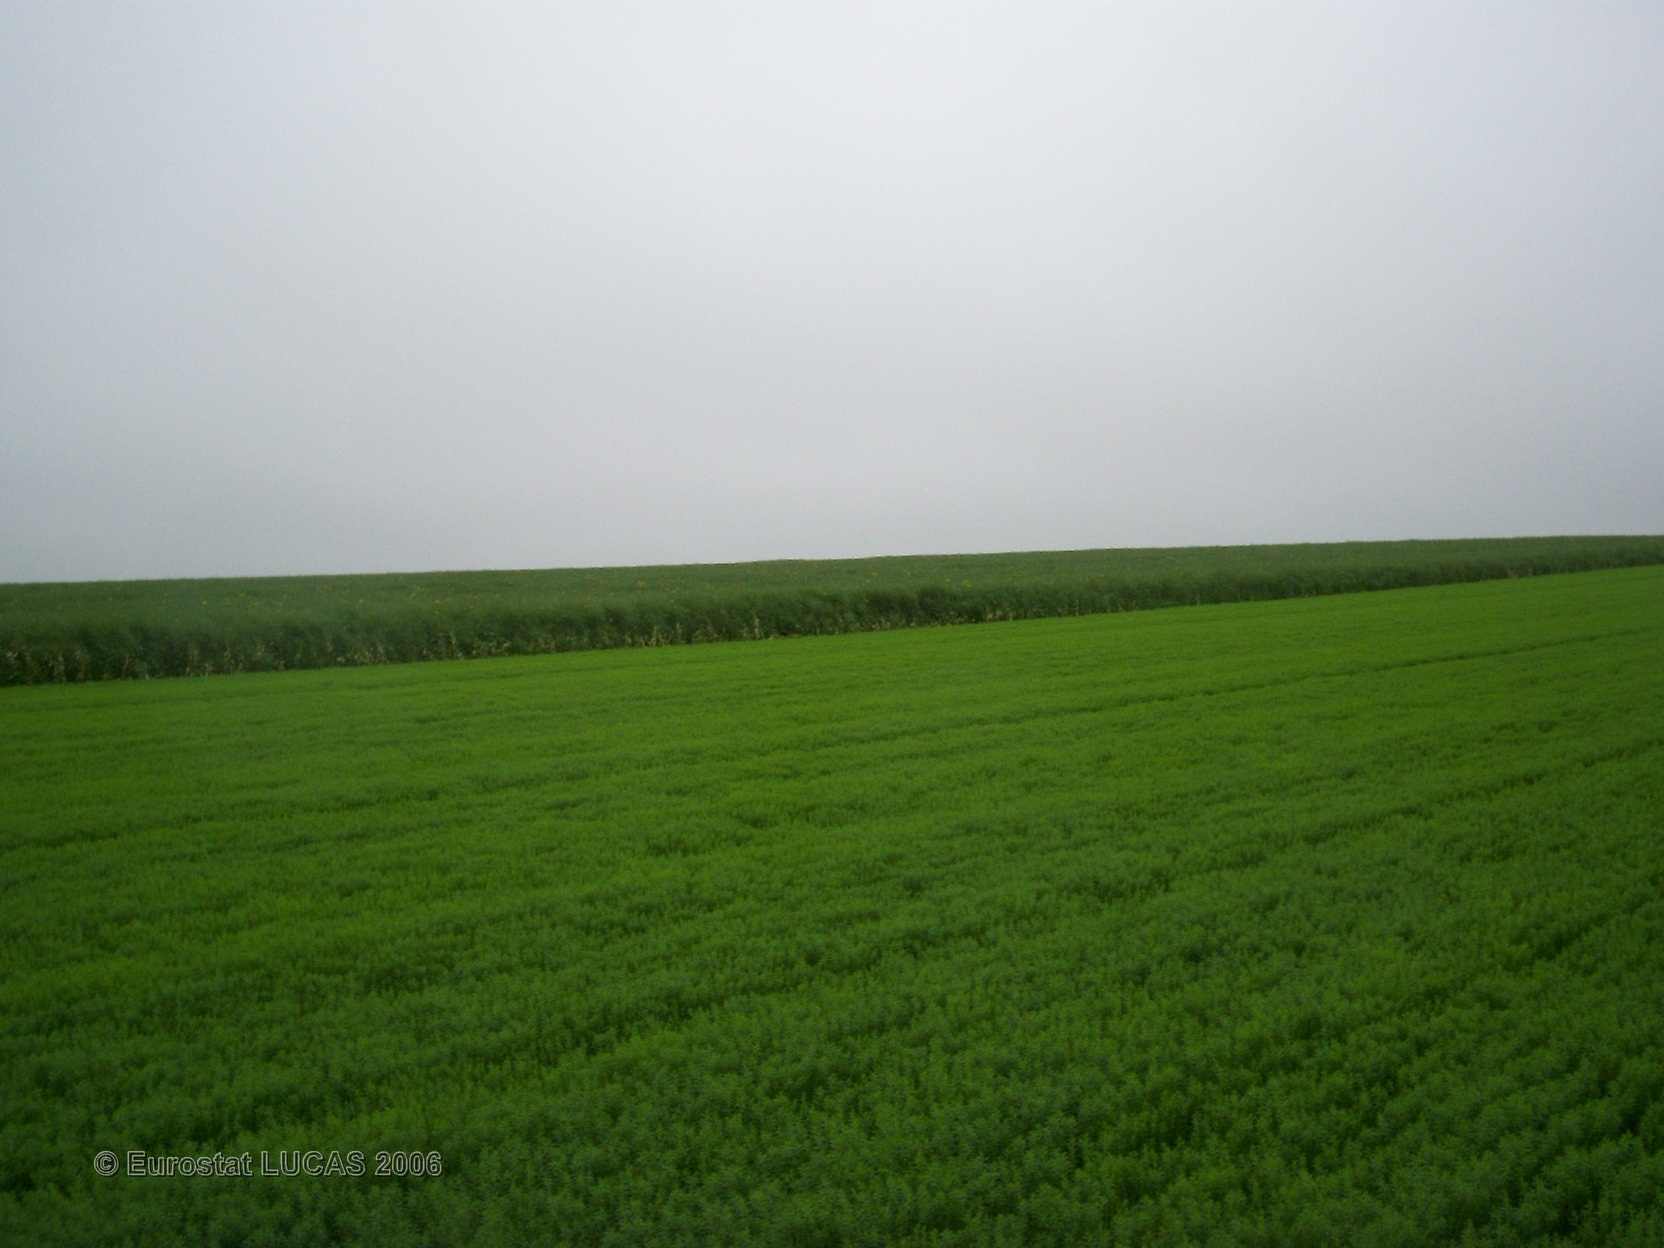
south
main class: Cropland
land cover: Other fibre and oleaginous crops
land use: Agriculture (excluding fallow land and kitchen gardens)
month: May
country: FR
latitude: 49.6392
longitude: 0.9067
